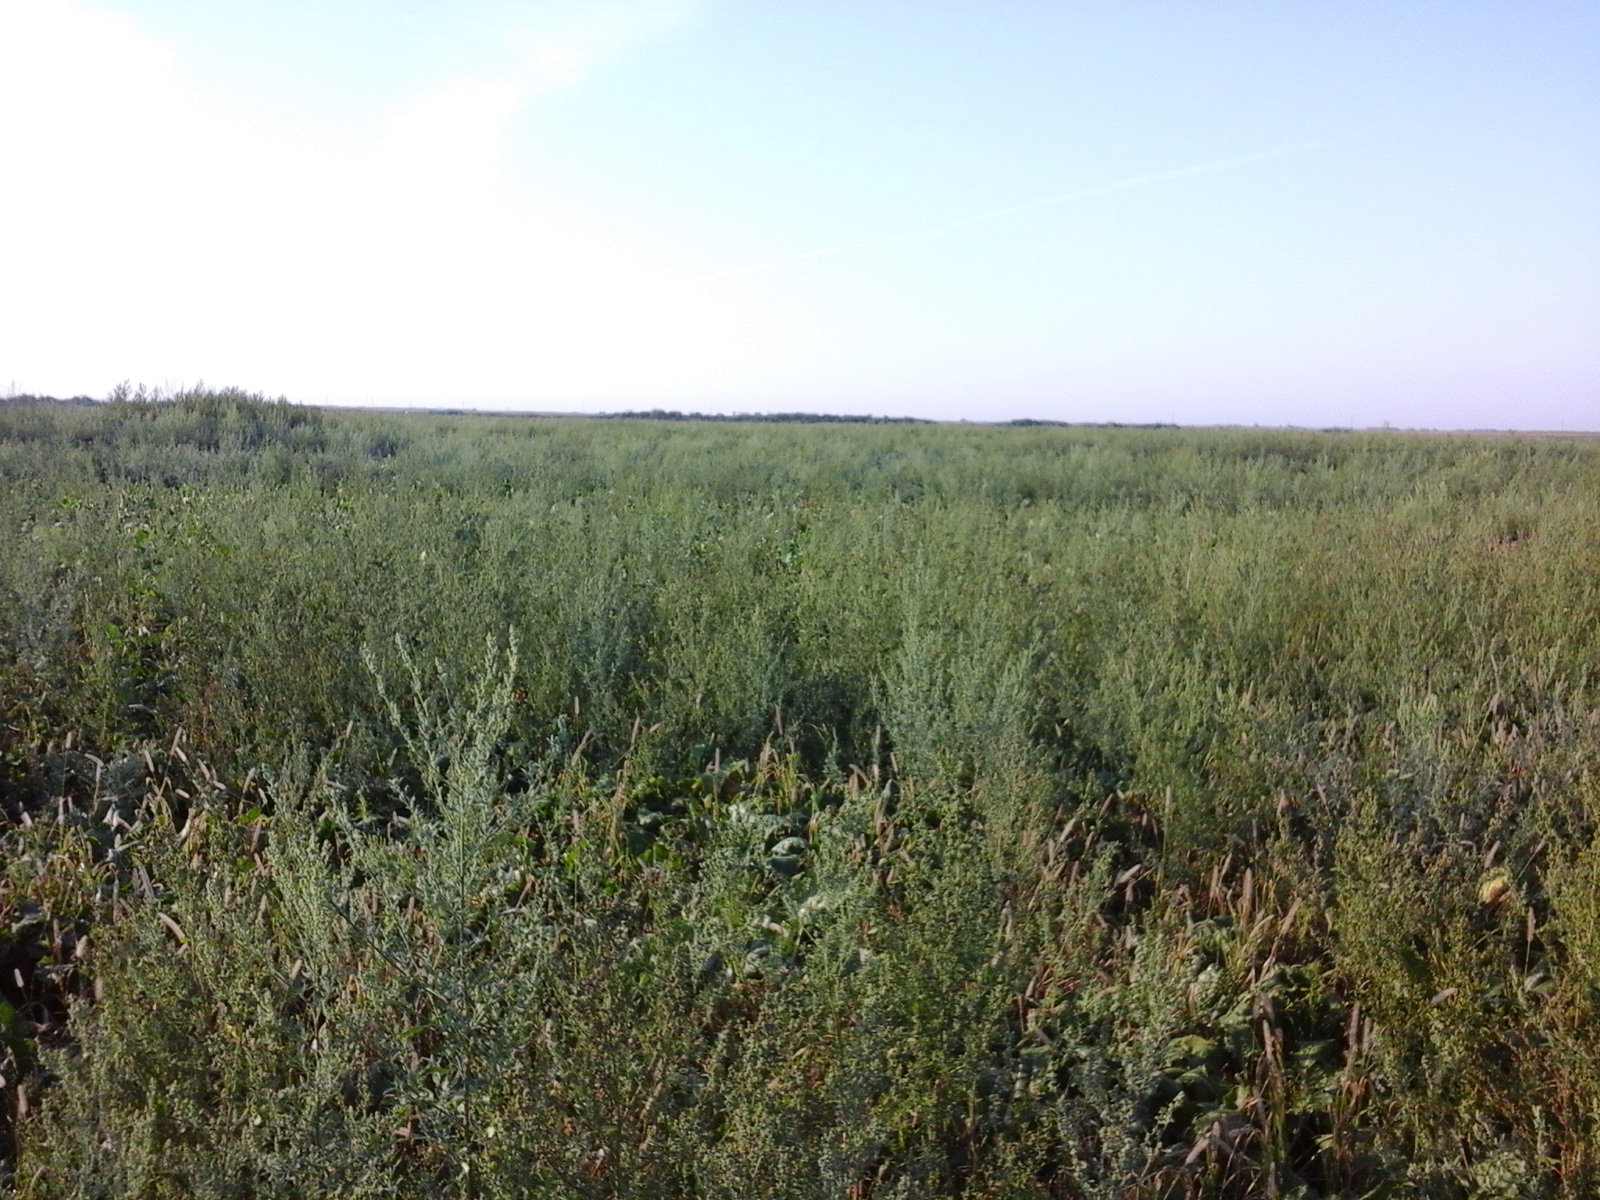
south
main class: Cropland
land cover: Sugar beet
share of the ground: 10 - 25 %
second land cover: Spontaneously vegetated surfaces
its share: > 75 %
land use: Agriculture (excluding fallow land and kitchen gardens)
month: August
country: RO
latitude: 45.7946
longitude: 21.0541
